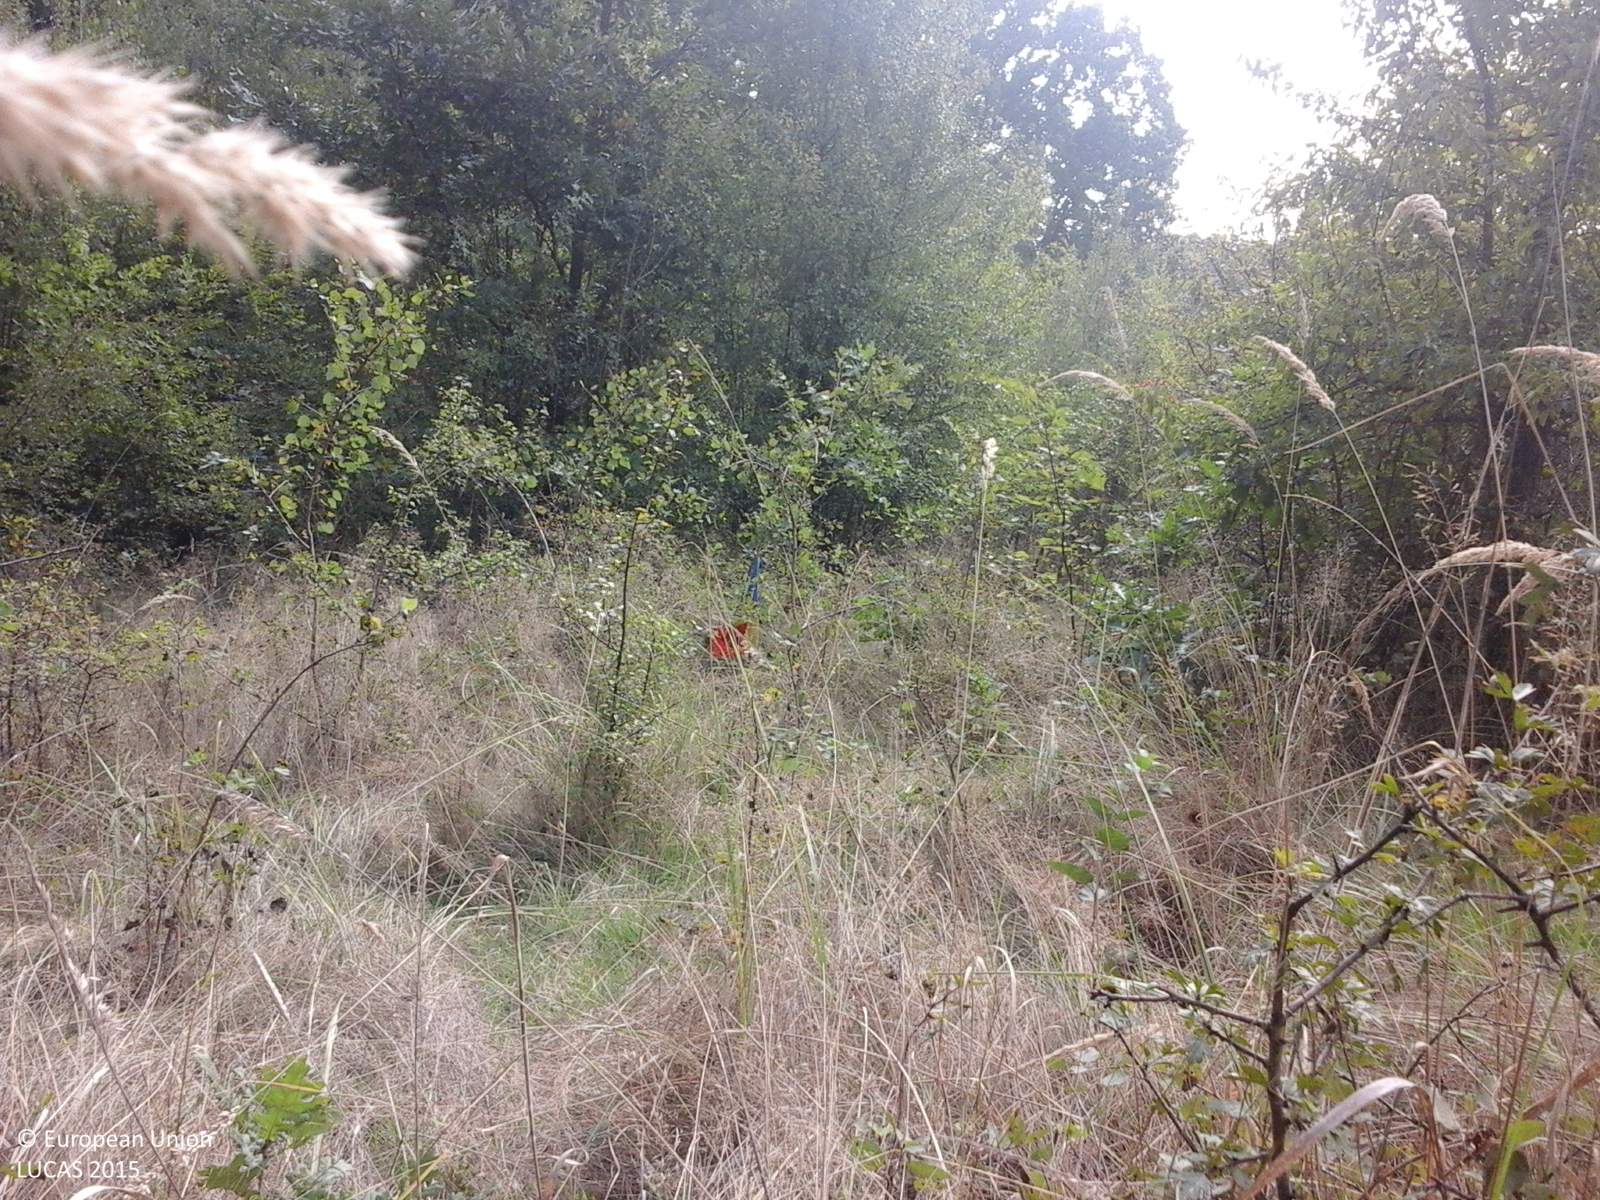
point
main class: Grassland
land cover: Grassland with sparse tree/shrub cover
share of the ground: > 75 %
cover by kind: herbaceous plants 85 %, shrubs 10 %, broadleaved forest trees 5 %
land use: Semi-natural and natural areas not in use
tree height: > 5 m
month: September
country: RO
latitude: 45.9462
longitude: 22.1564
